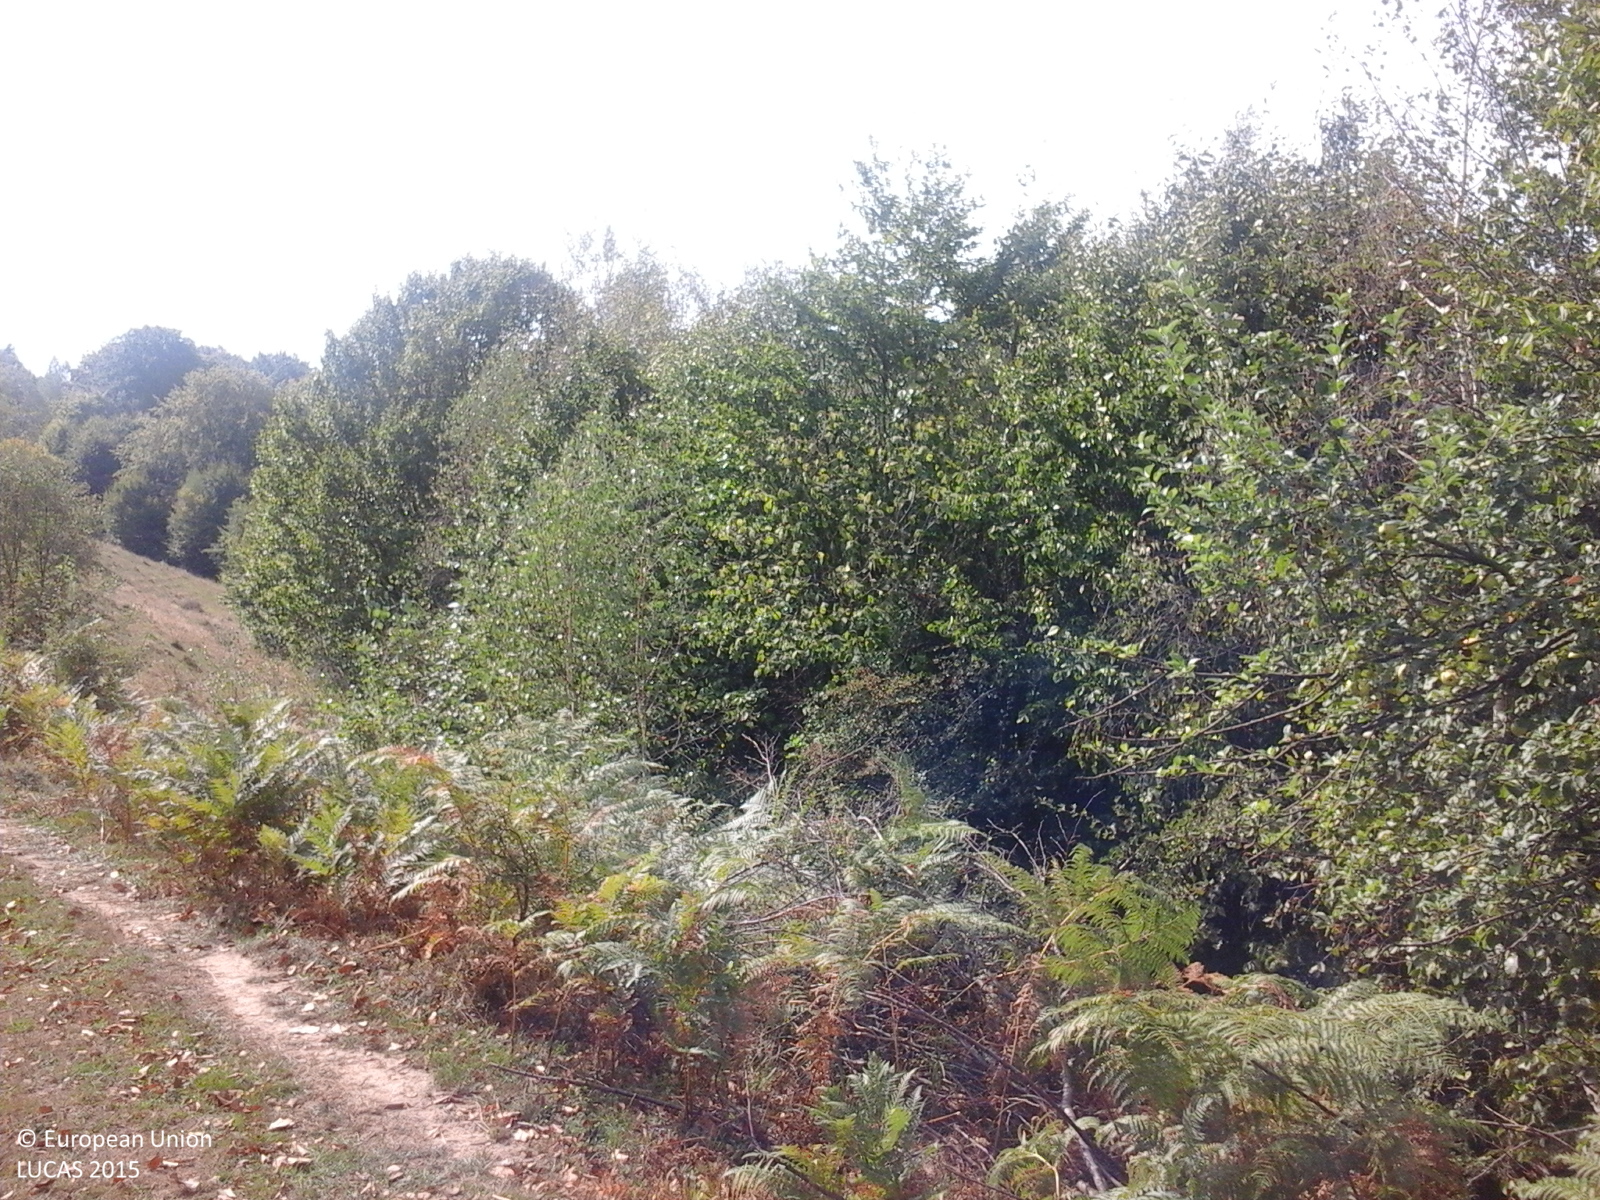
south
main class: Grassland
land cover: Grassland without tree/shrub cover
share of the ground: > 75 %
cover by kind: herbaceous plants 100 %
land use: Agriculture (excluding fallow land and kitchen gardens)
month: September
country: RO
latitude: 47.4353
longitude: 23.9914
